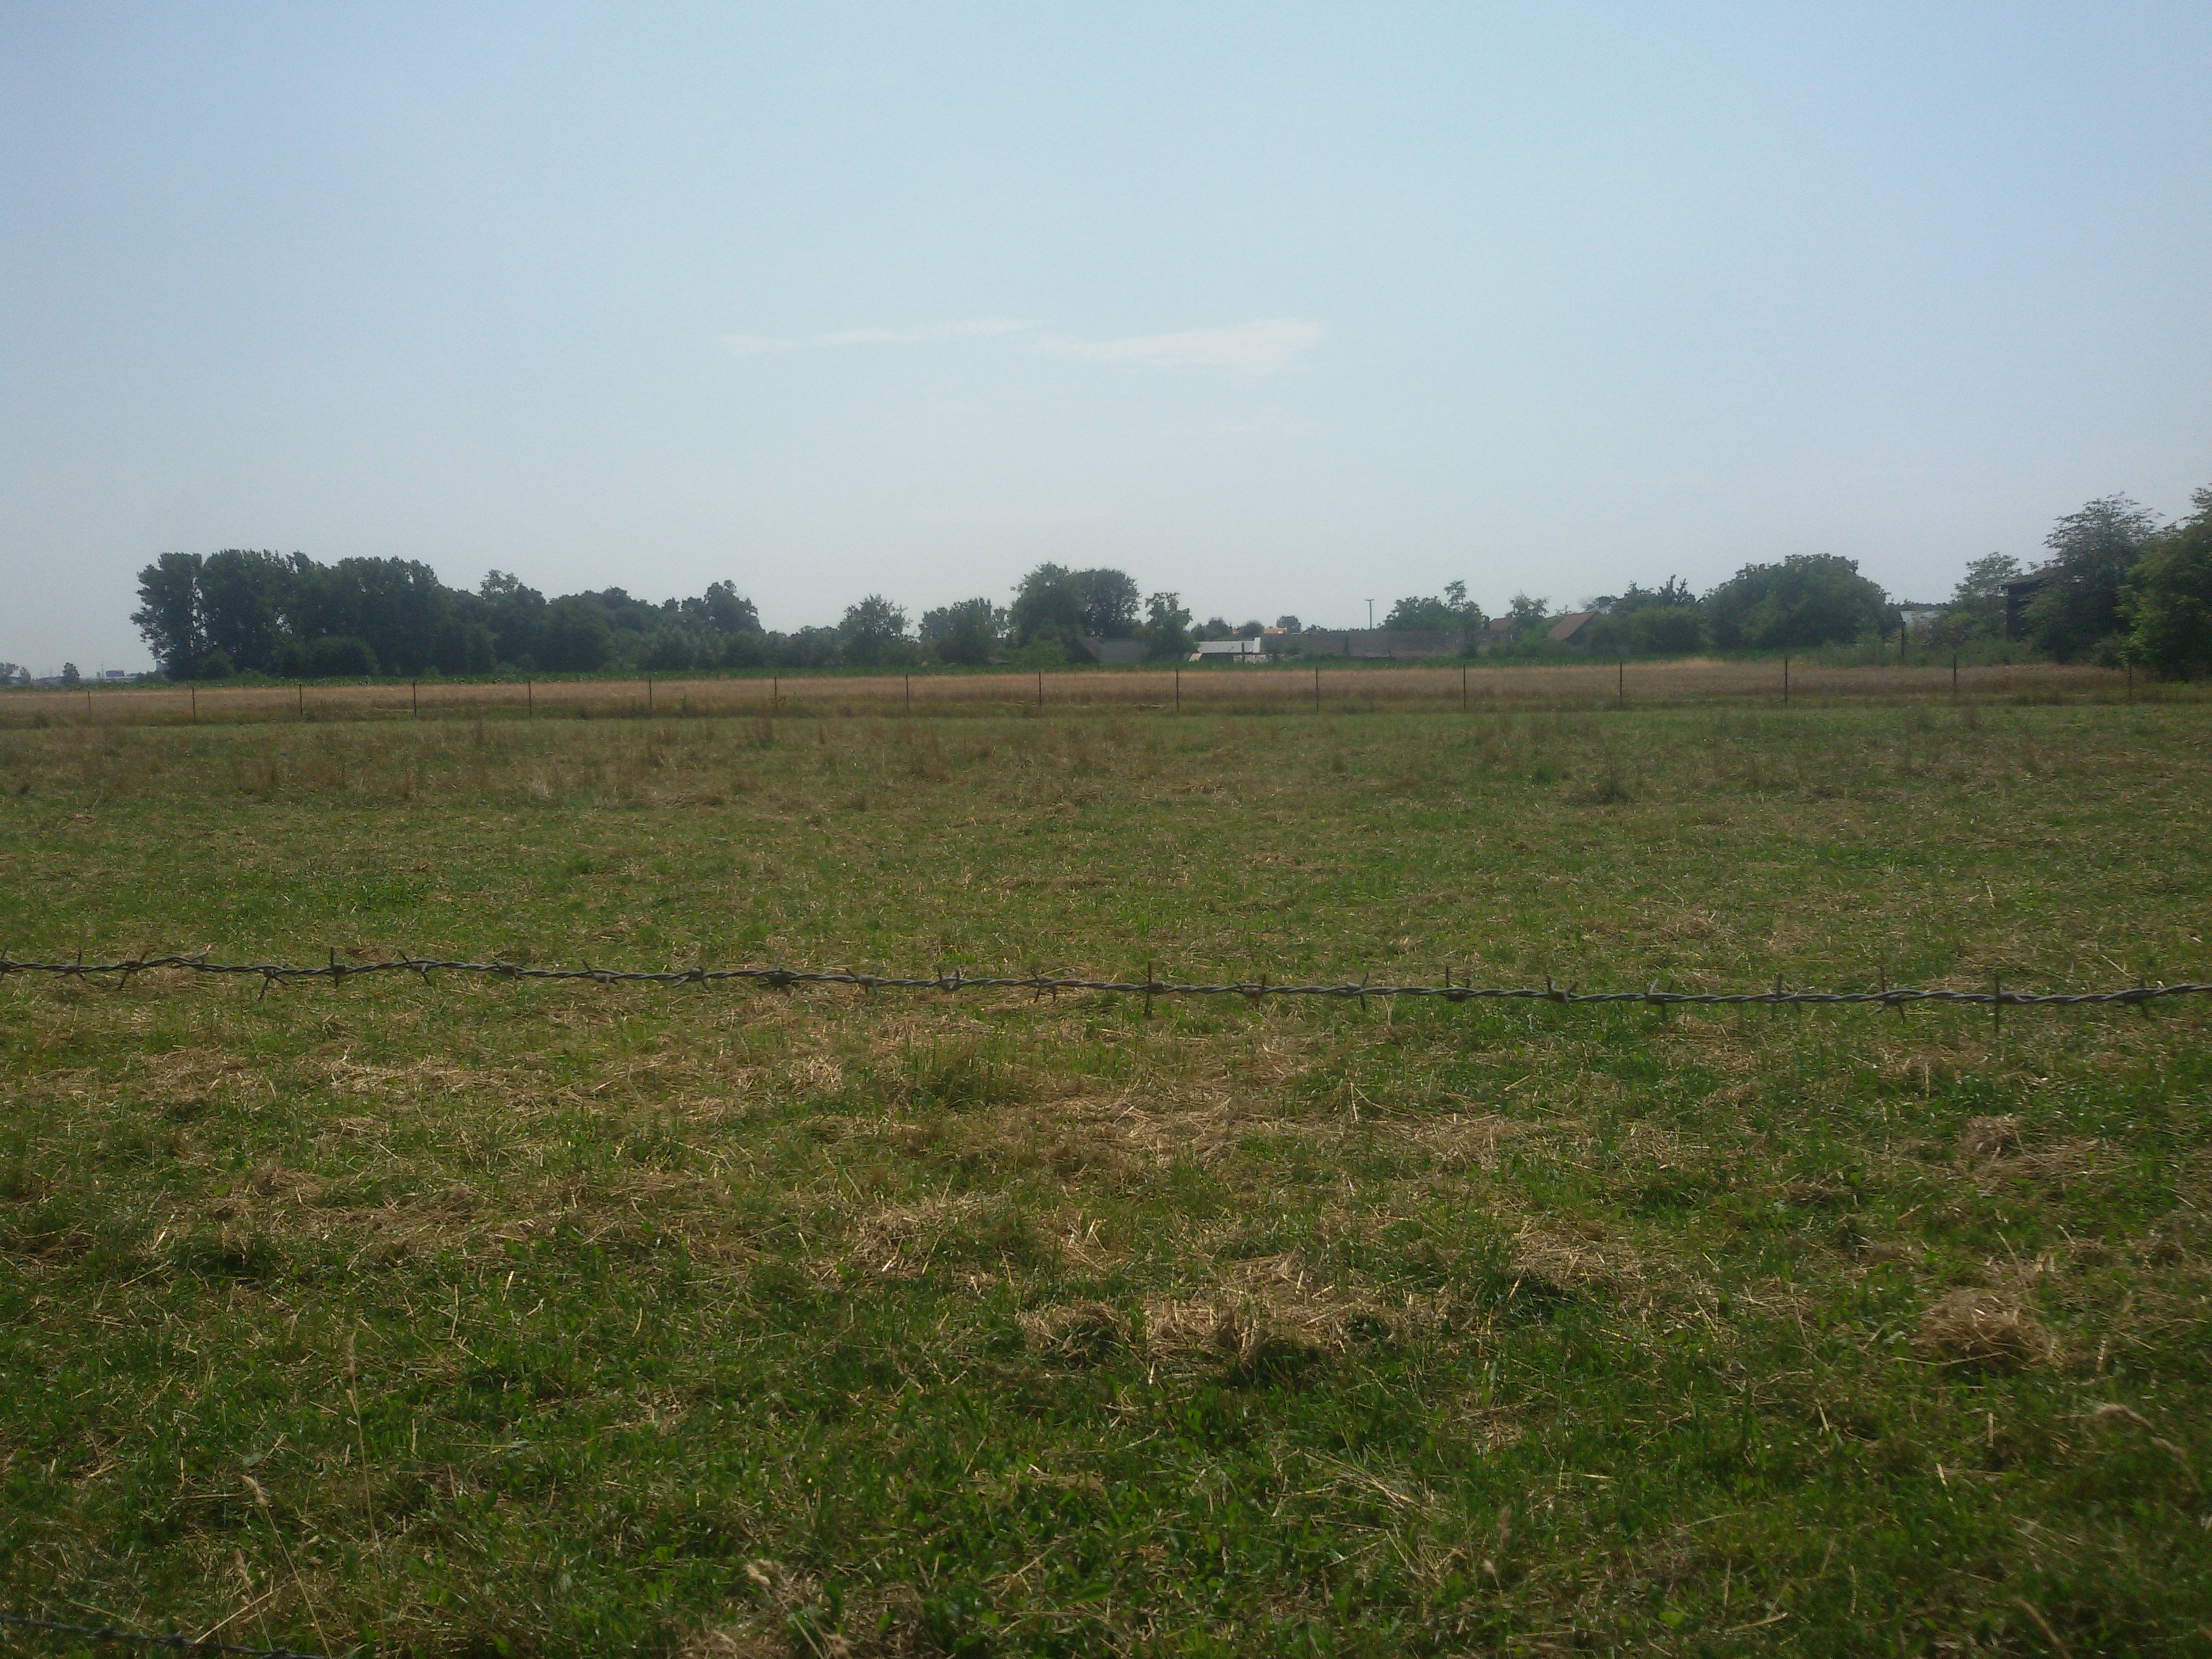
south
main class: Cropland
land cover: Rape and turnip rape
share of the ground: > 75 %
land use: Agriculture (excluding fallow land and kitchen gardens)
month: July
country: PL
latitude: 50.3042
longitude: 22.4054
